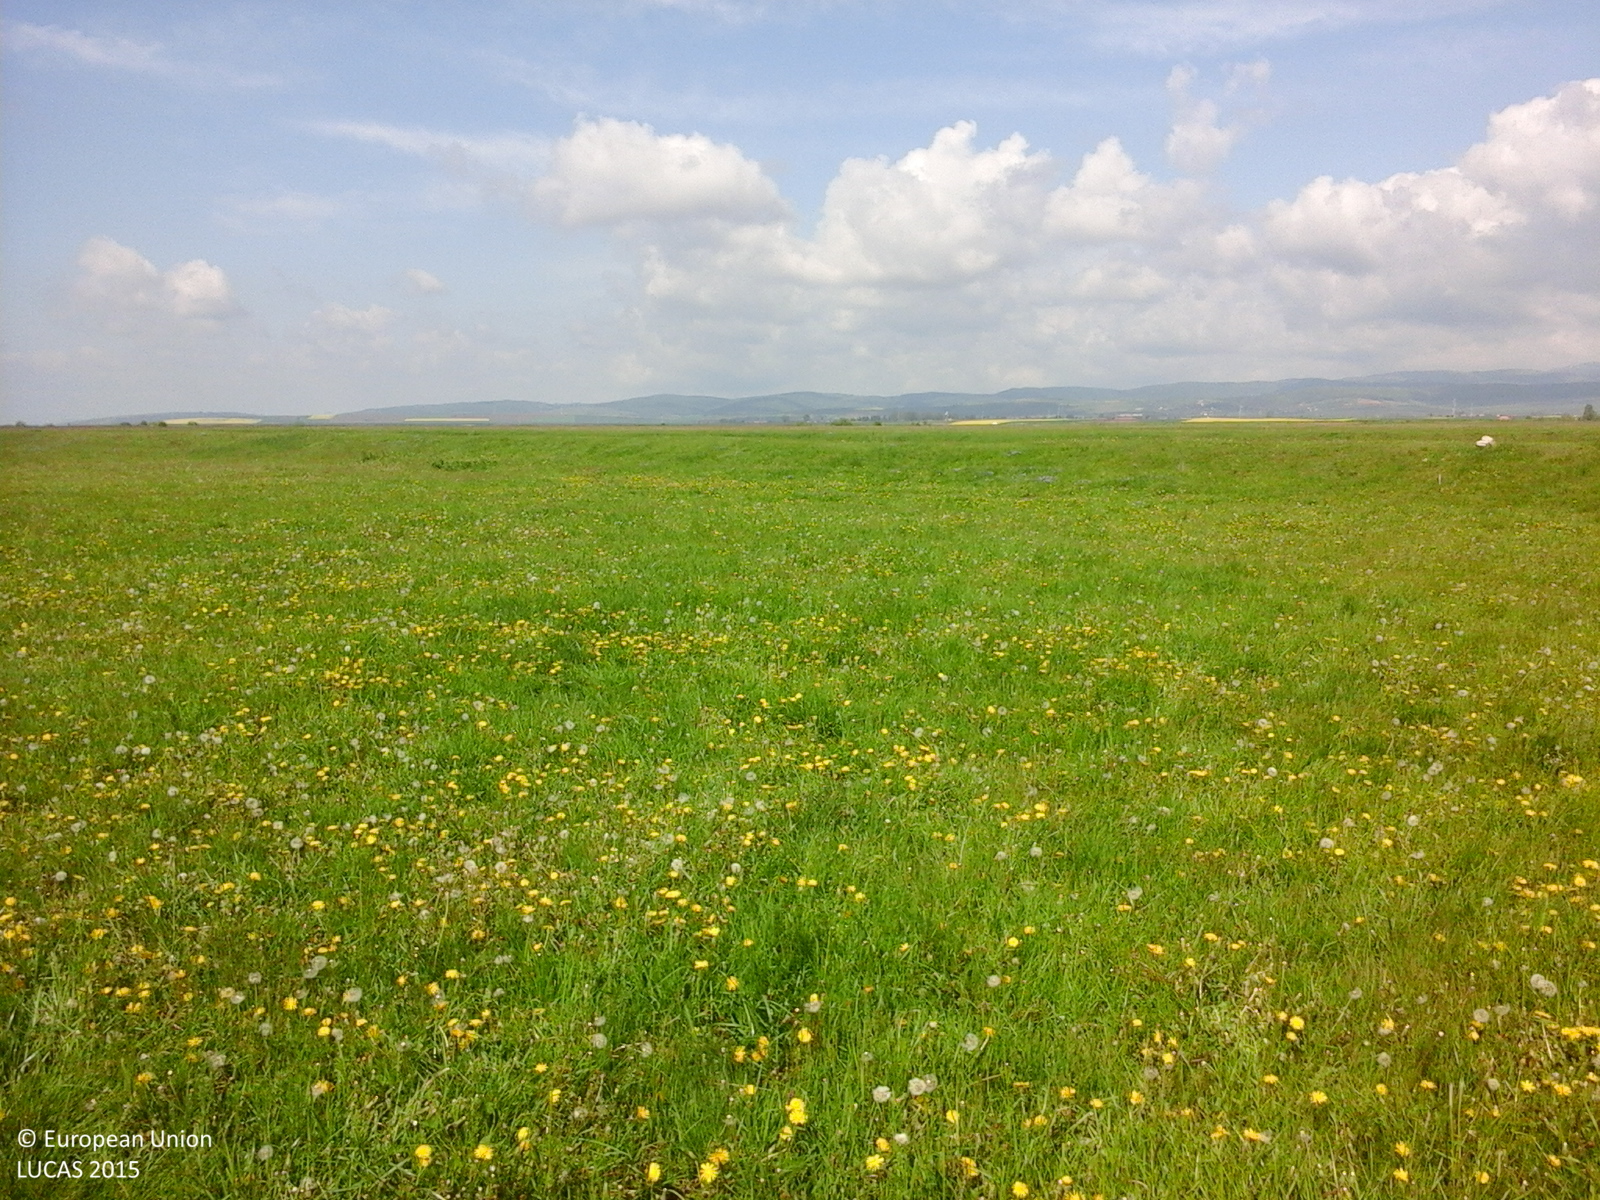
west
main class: Grassland
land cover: Grassland without tree/shrub cover
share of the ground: > 75 %
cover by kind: herbaceous plants 100 %
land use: Agriculture (excluding fallow land and kitchen gardens)
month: May
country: RO
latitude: 45.9079
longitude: 26.1170
